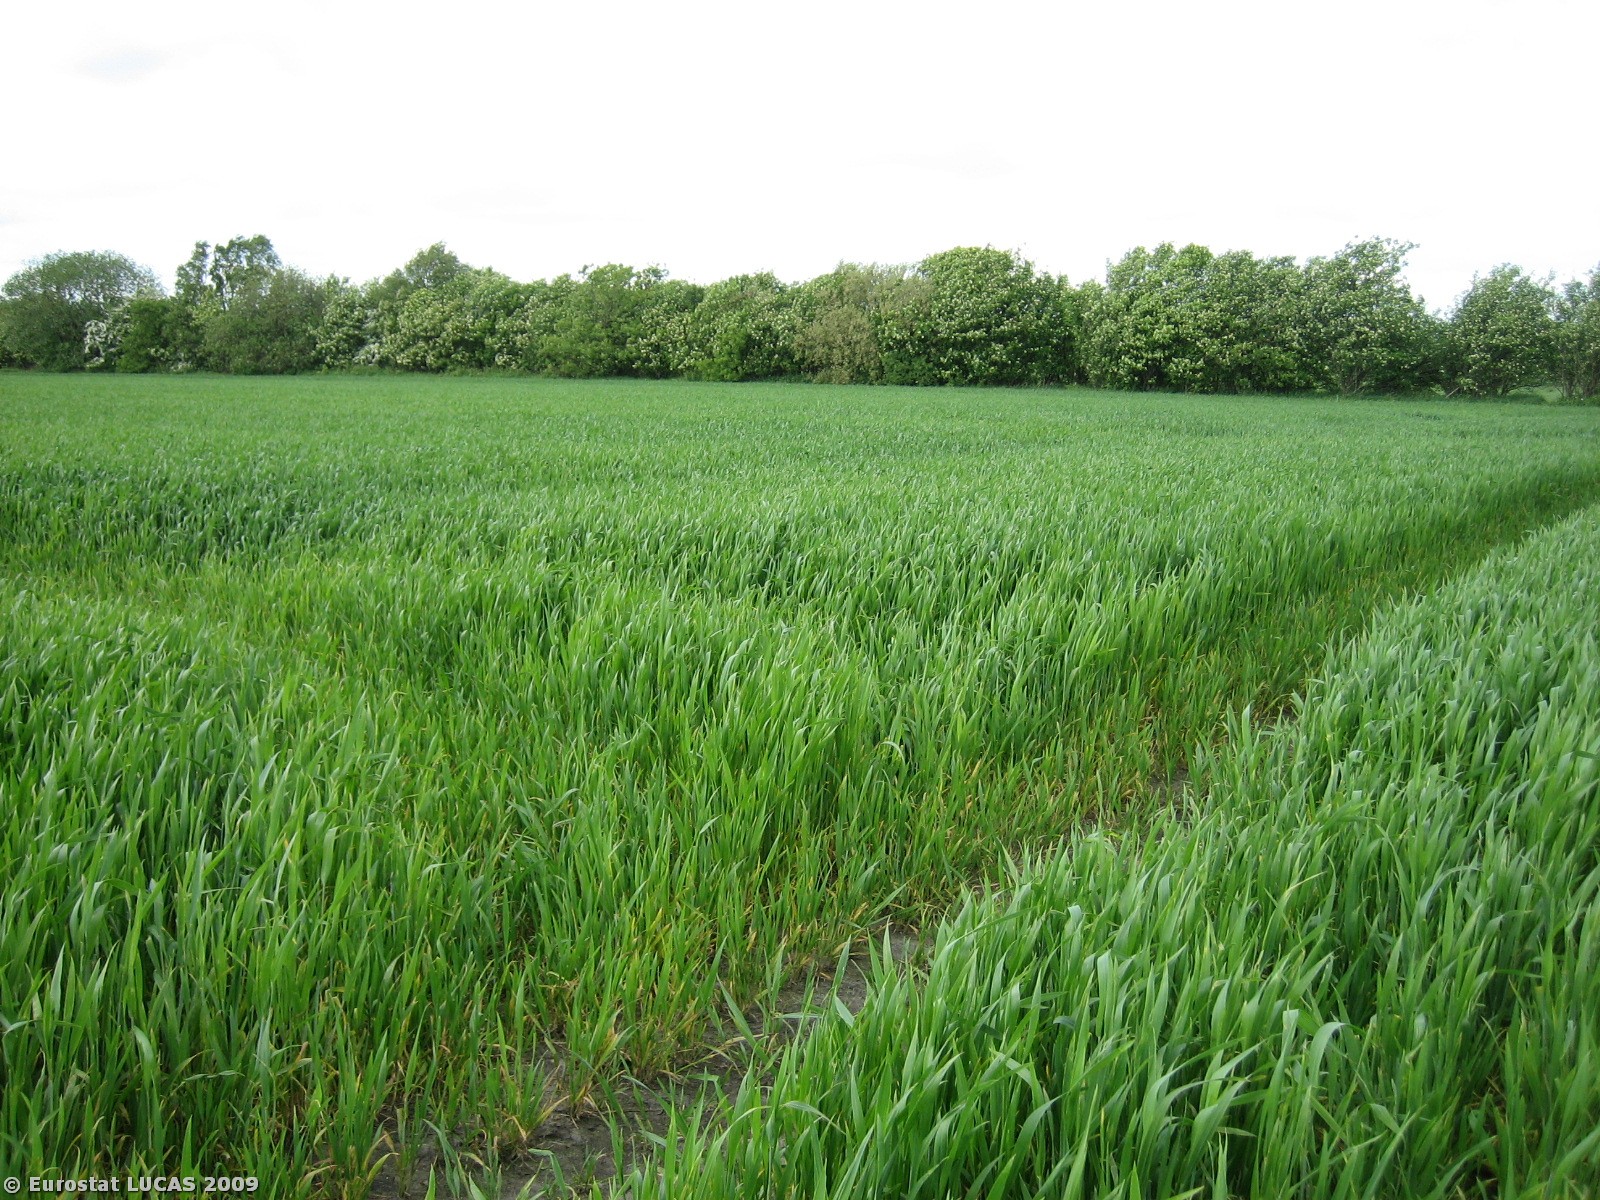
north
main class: Cropland
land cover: Barley
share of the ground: > 75 %
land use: Agriculture (excluding fallow land and kitchen gardens)
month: May
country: DK
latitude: 56.0212
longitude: 8.8942
